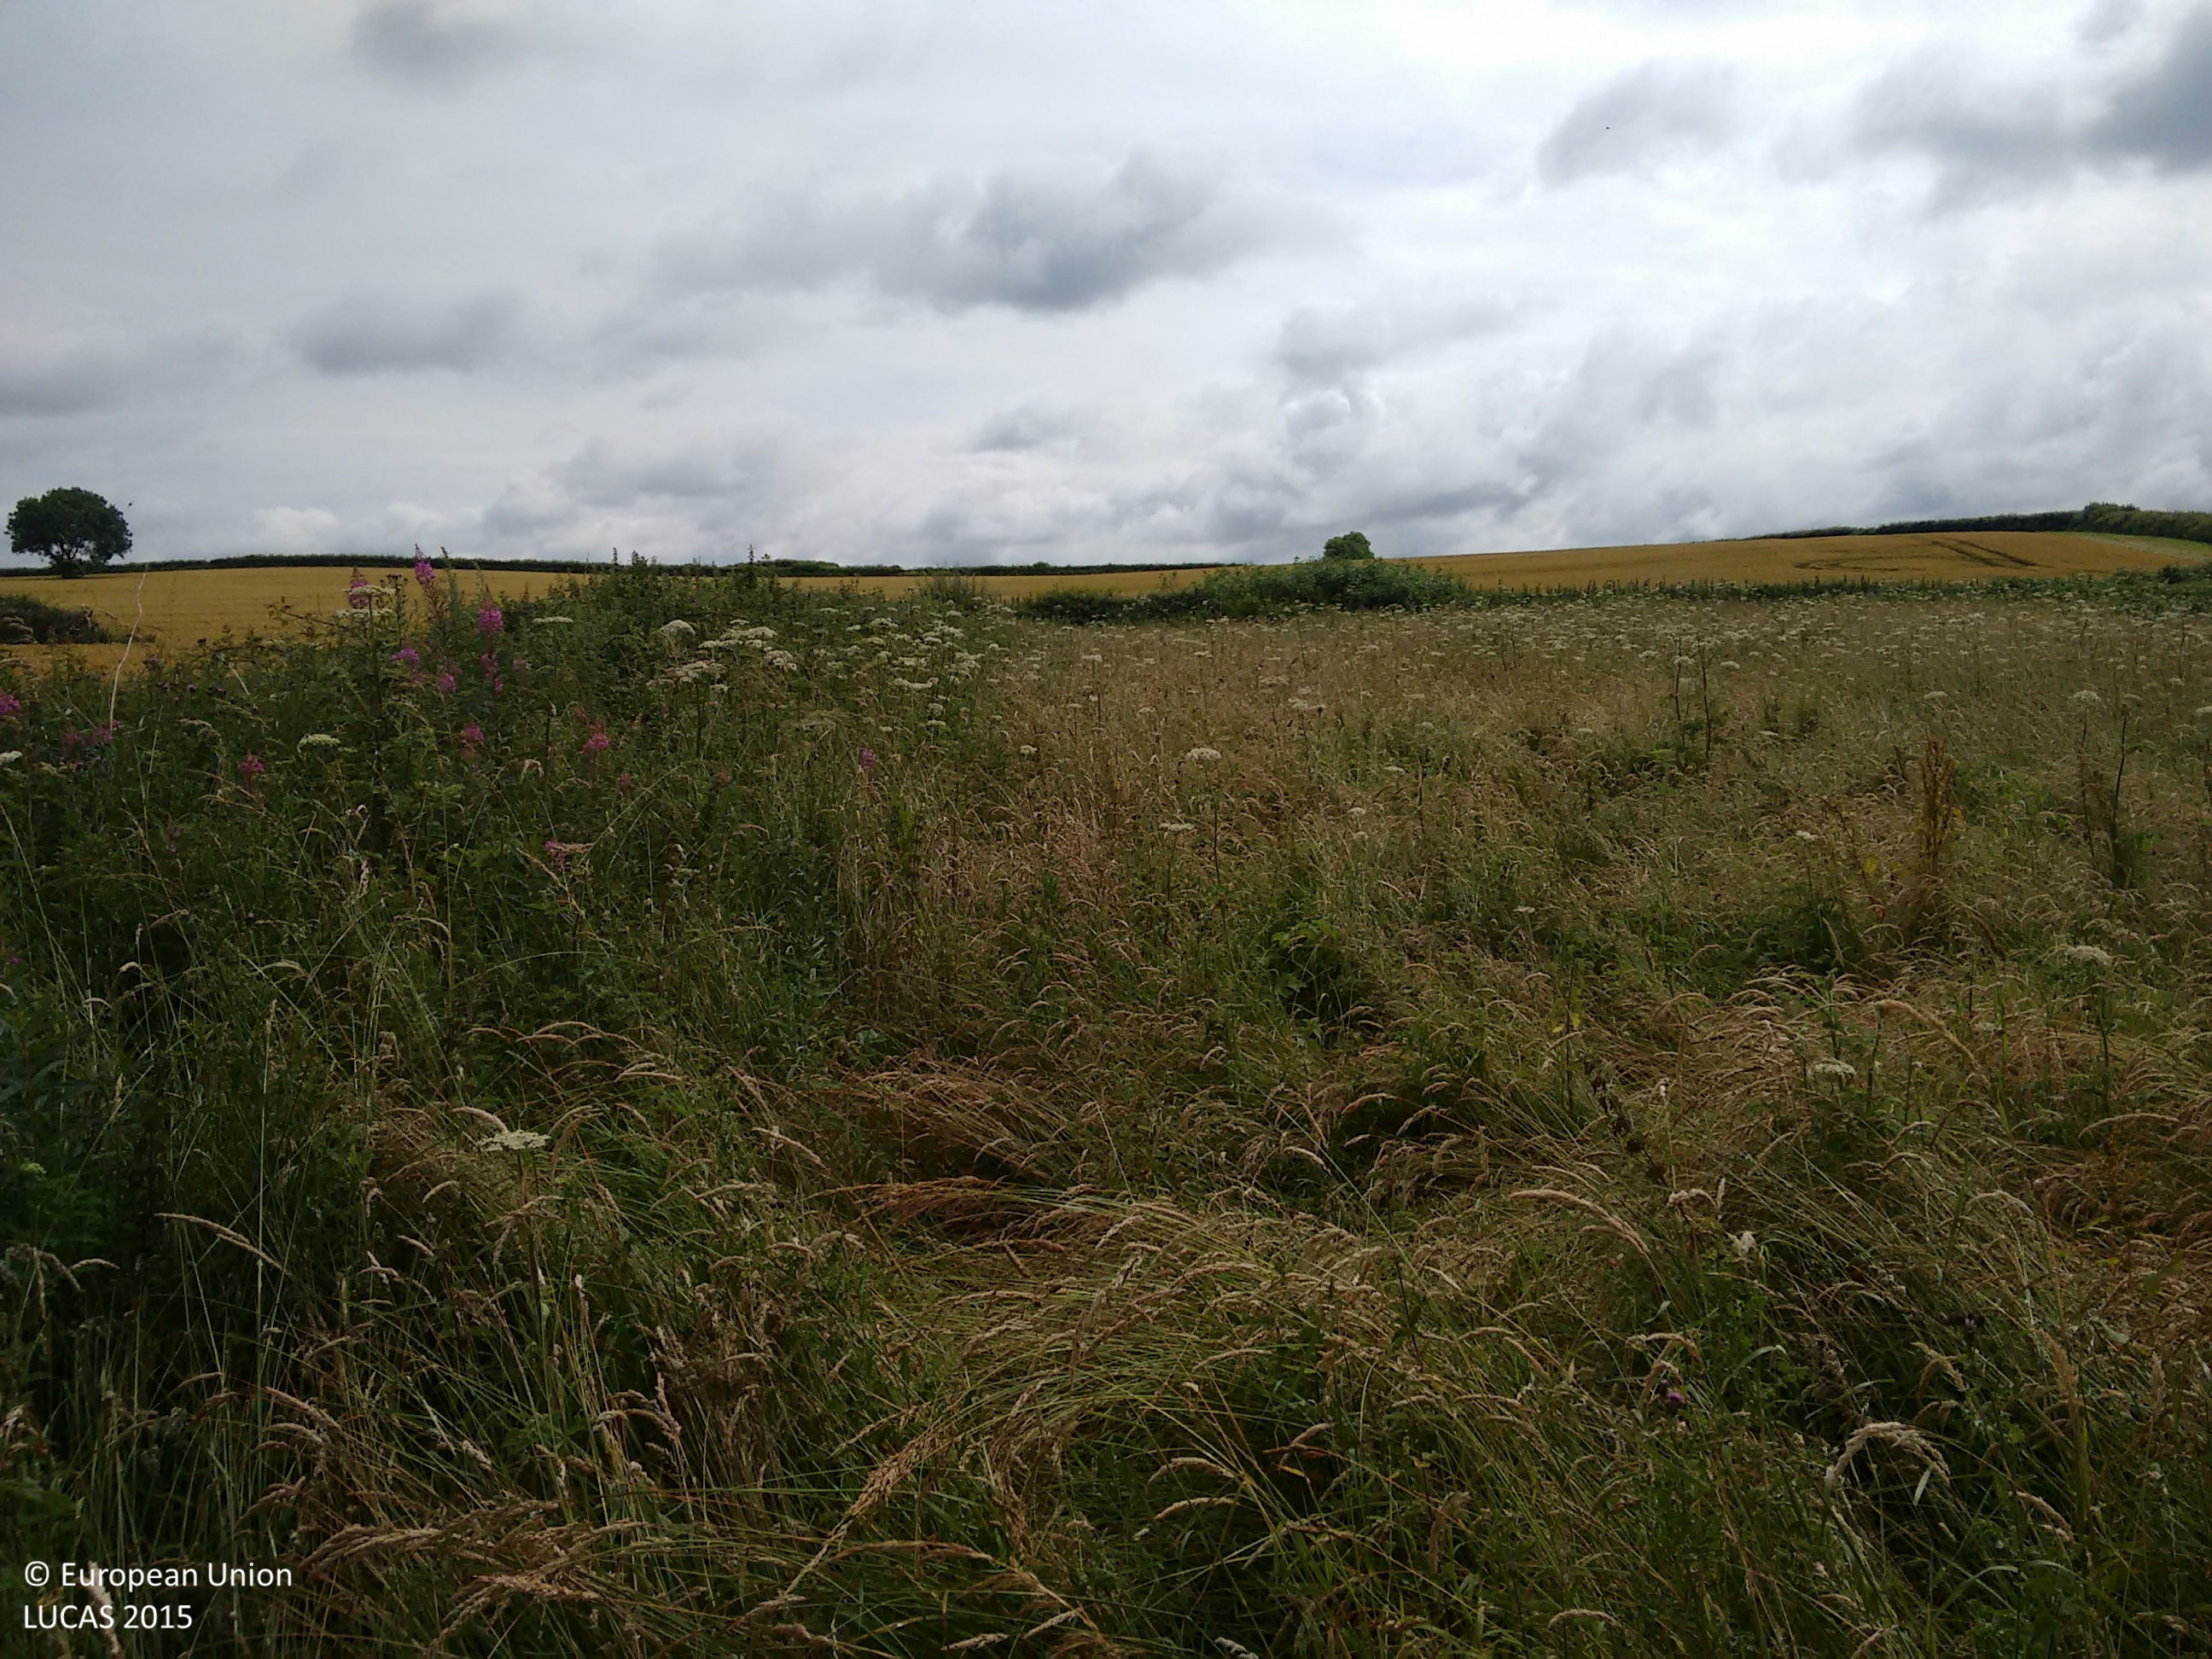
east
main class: Grassland
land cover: Grassland without tree/shrub cover
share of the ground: > 75 %
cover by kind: herbaceous plants 100 %
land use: Abandoned areas
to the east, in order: Grassland without tree/shrub cover; Managed hedges; Fences; Common wheat
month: July
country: GB
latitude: 51.4939
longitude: -3.6410
